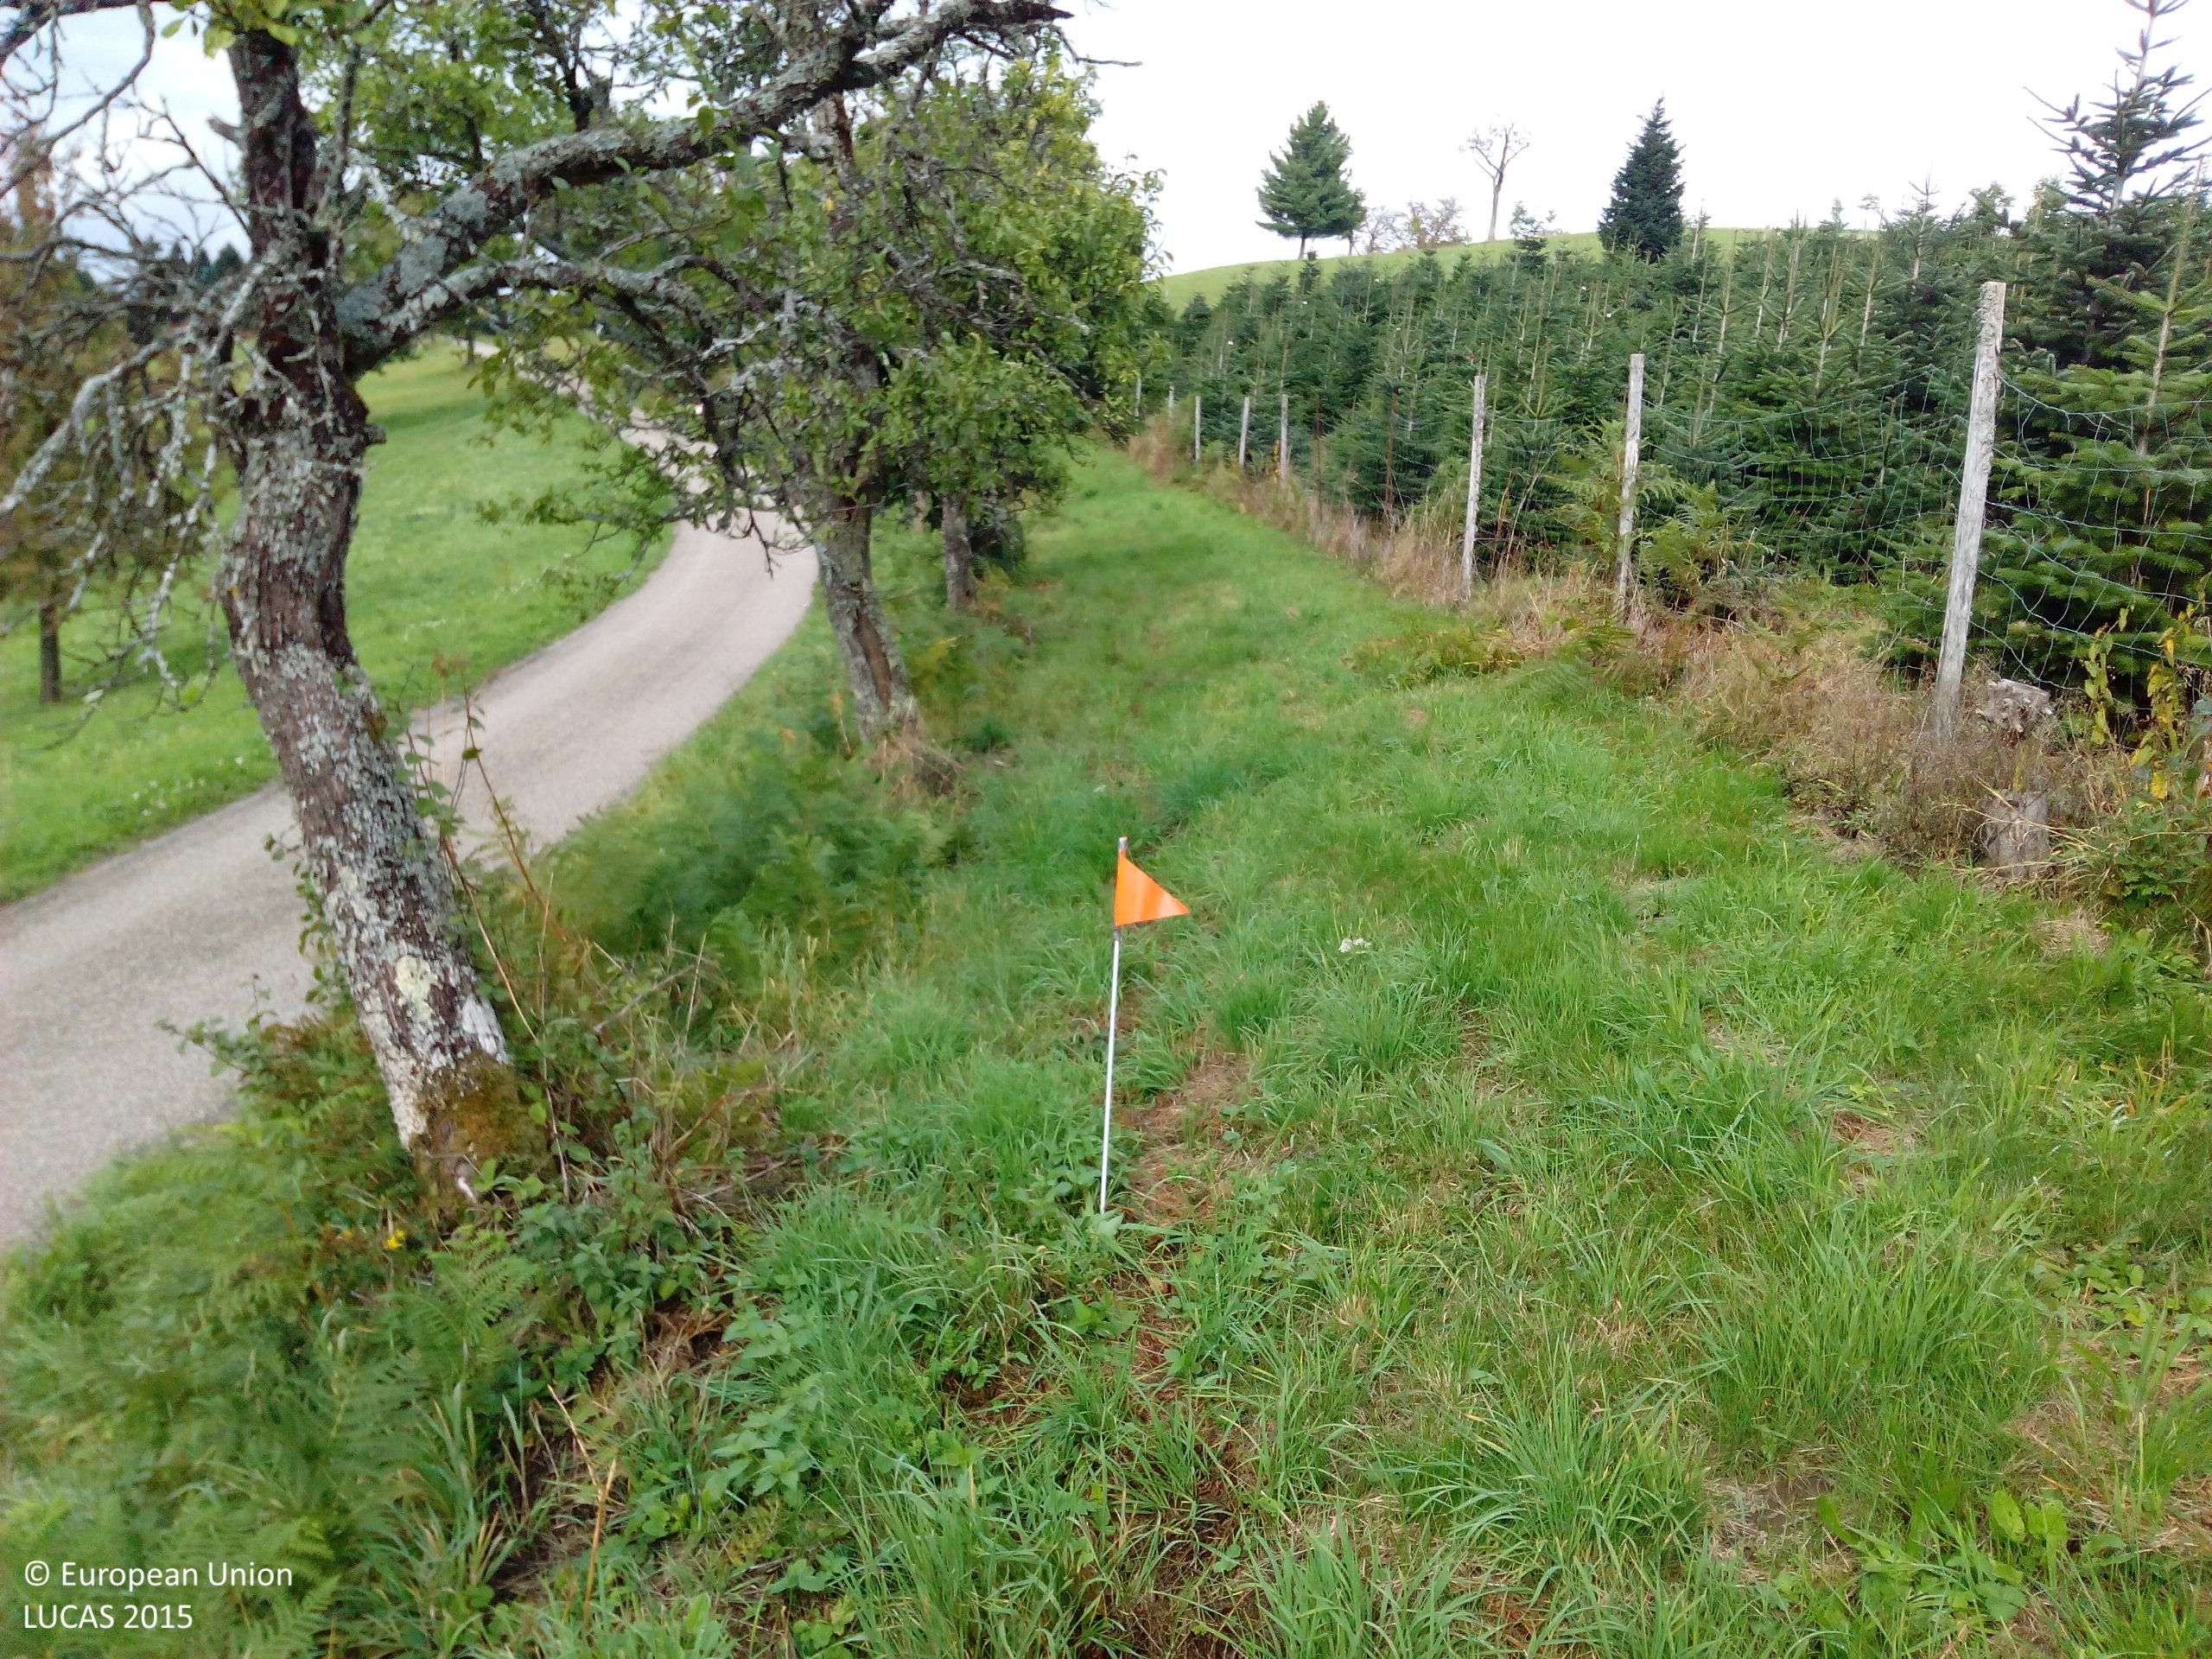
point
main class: Cropland
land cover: Other fruit trees and berries
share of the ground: 10 - 25 %
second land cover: Grassland without tree/shrub cover
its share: > 75 %
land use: Agriculture (excluding fallow land and kitchen gardens)
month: September
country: DE
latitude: 48.3332
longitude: 8.0989
